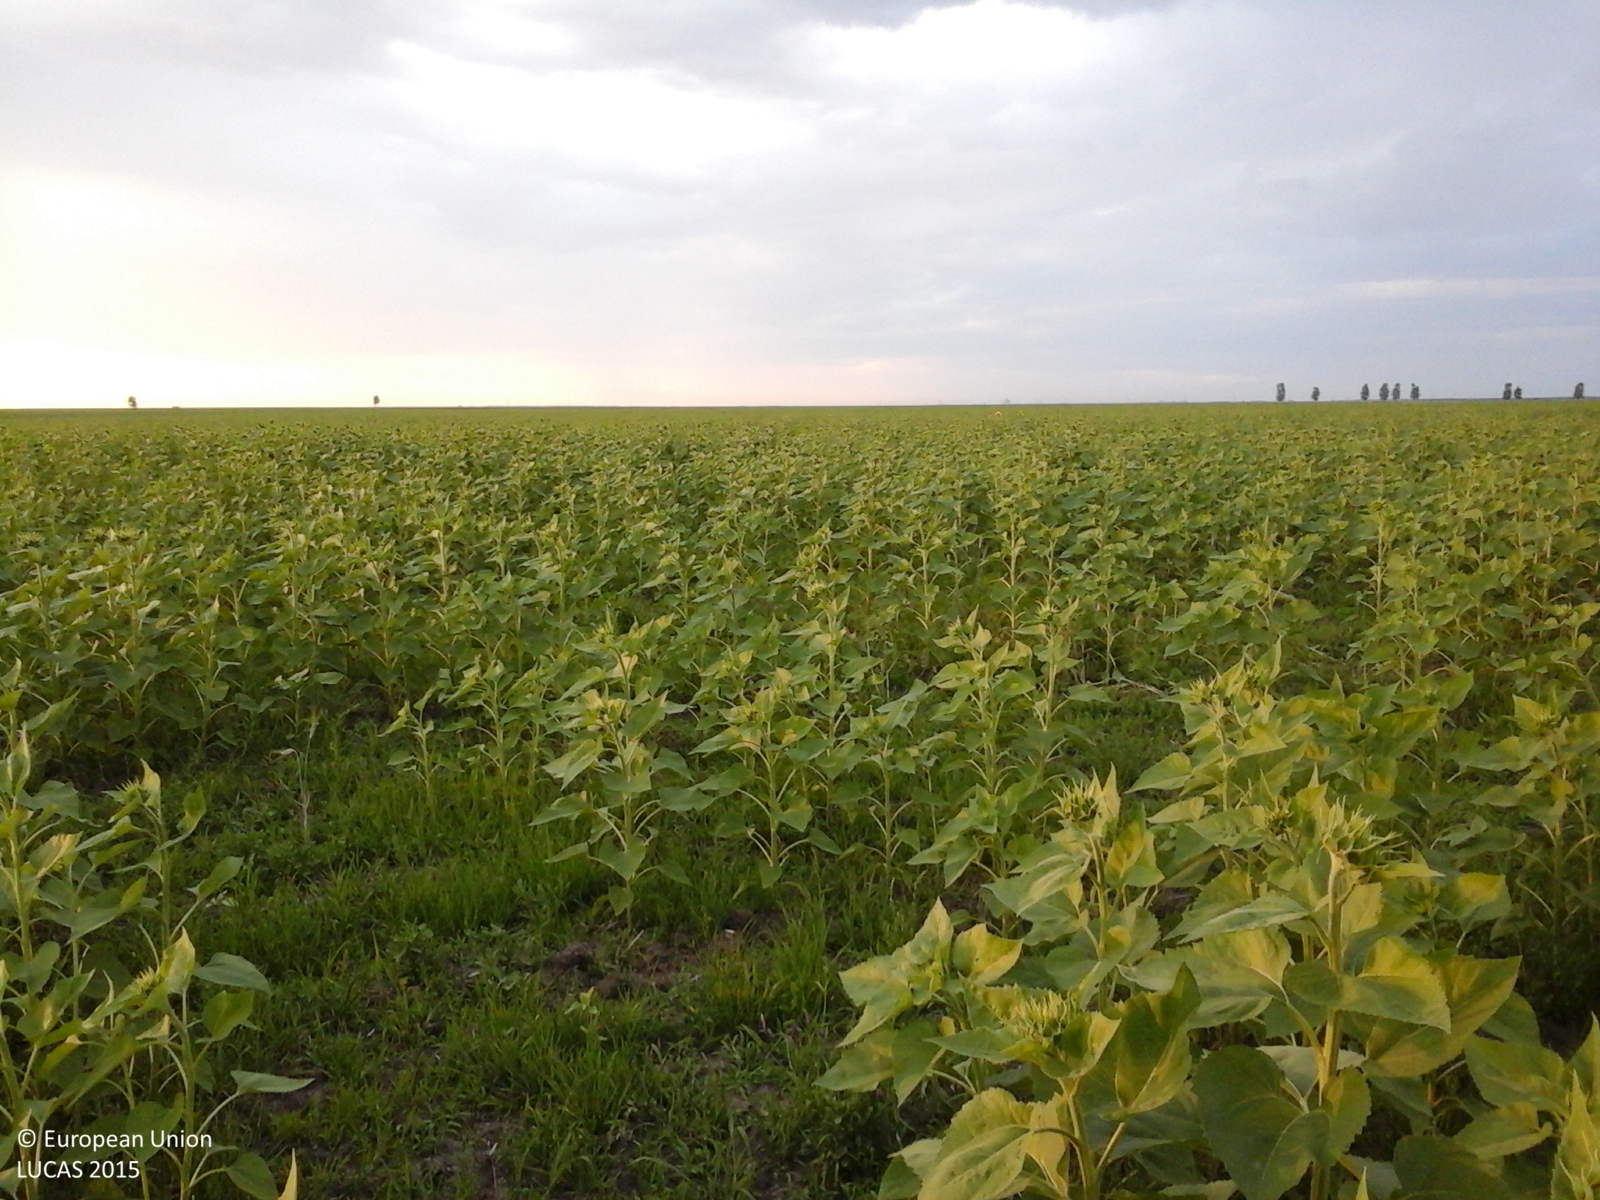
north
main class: Cropland
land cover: Sunflower
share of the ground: 50 - 75 %
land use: Agriculture (excluding fallow land and kitchen gardens)
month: July
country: RO
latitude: 44.3317
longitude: 24.8880
